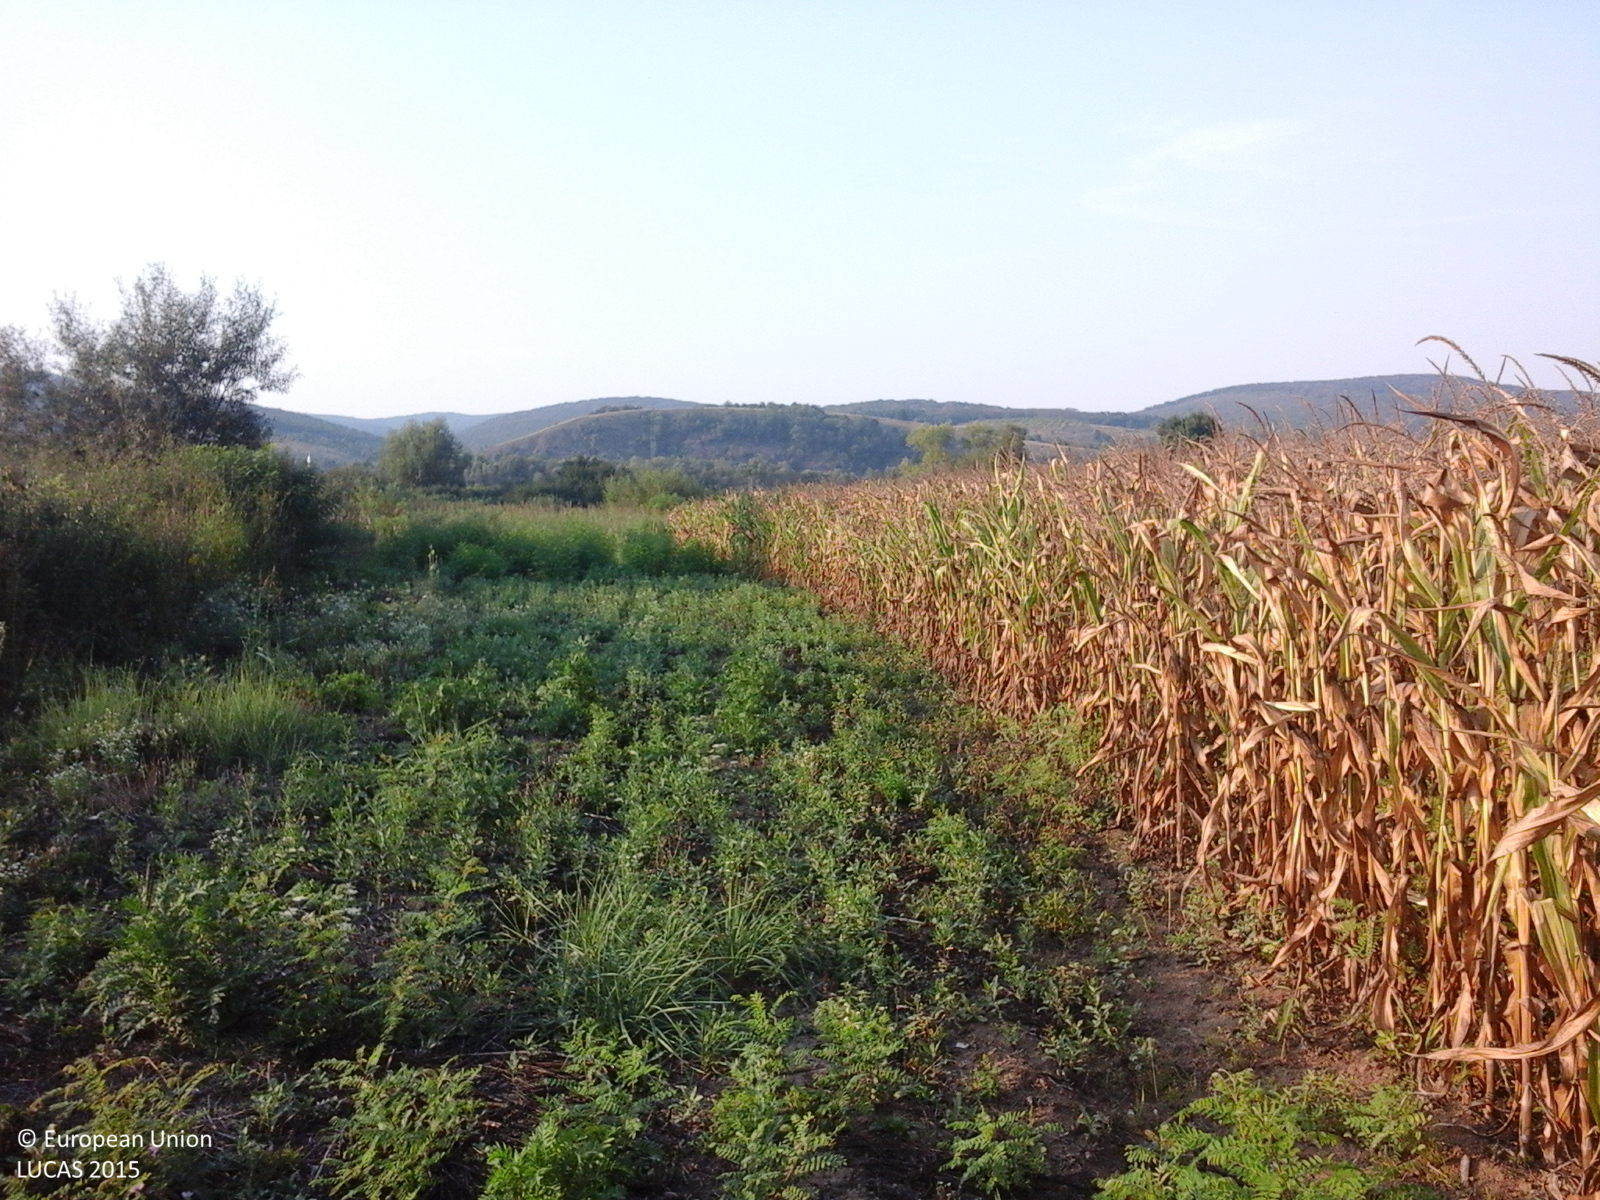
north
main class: Cropland
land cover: Maize
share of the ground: > 75 %
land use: Agriculture (excluding fallow land and kitchen gardens)
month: August
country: RO
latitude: 46.0260
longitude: 22.0959
